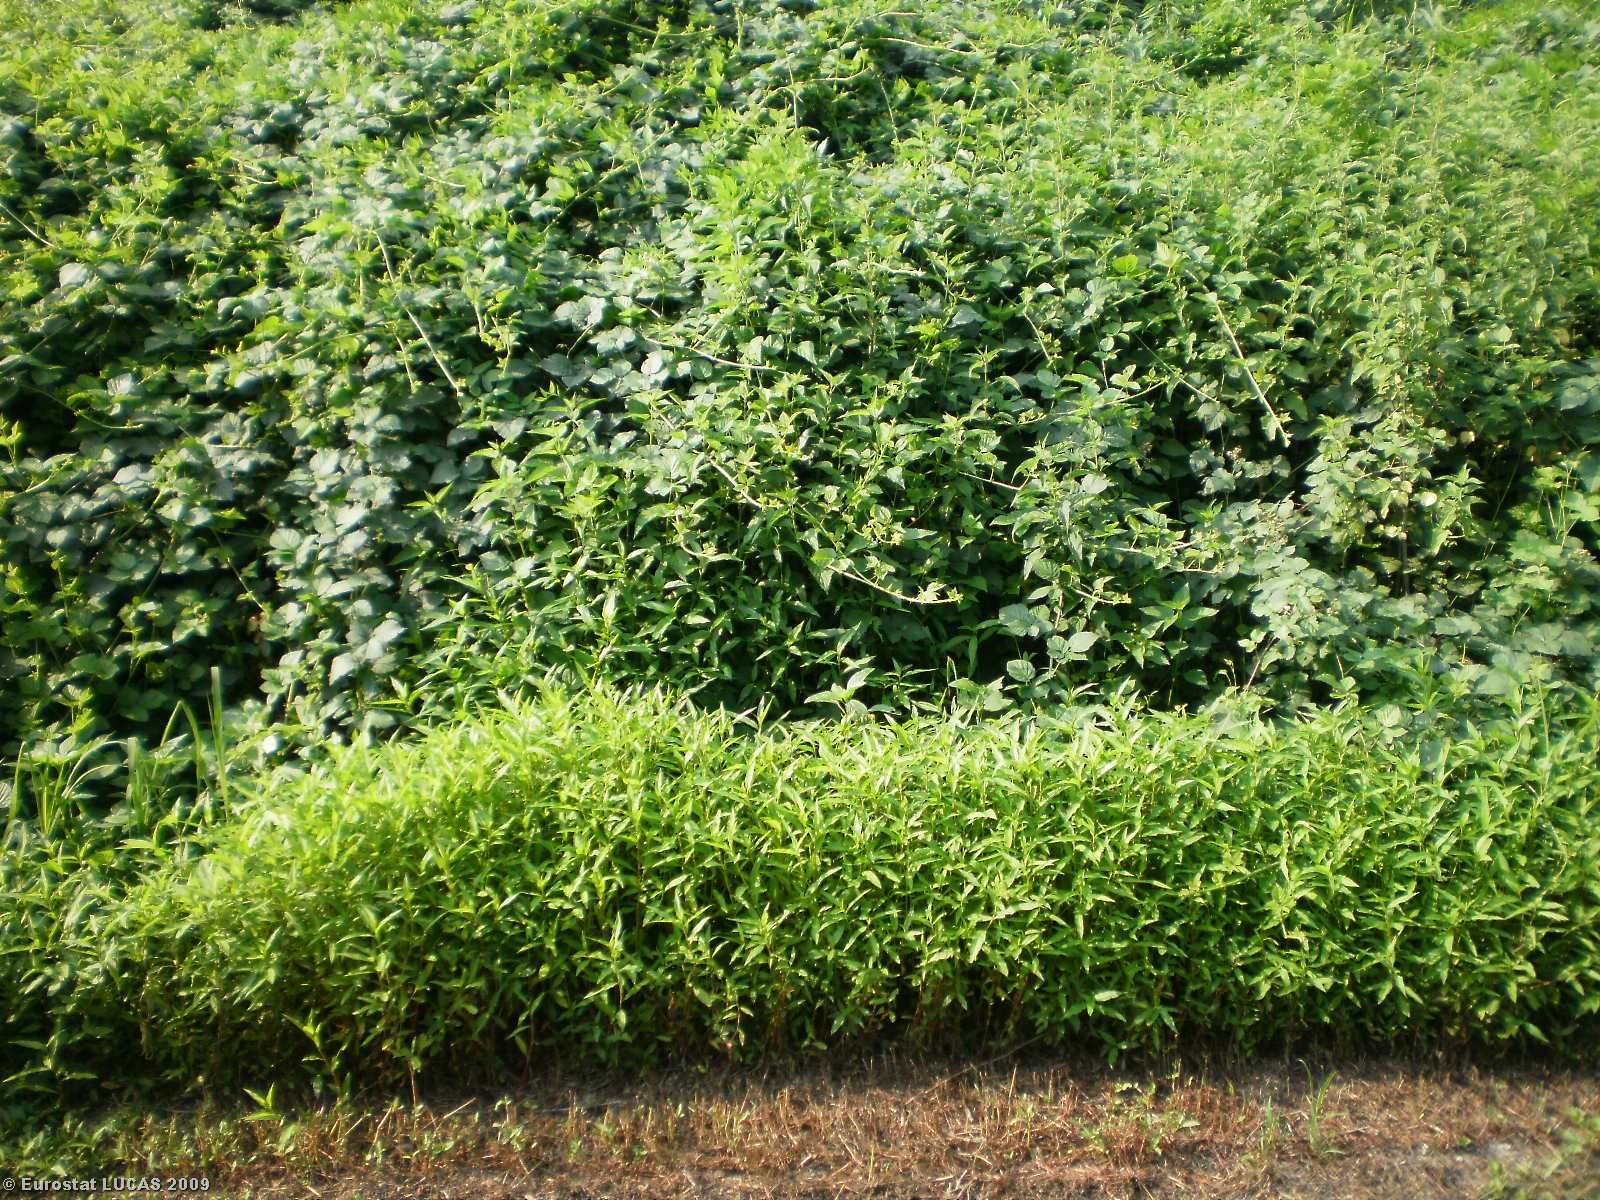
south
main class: Woodland
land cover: Broadleaved woodland
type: non-riverine alder, birch or aspen forest
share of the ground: > 75 %
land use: Forestry
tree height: > 5 m
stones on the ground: < 10 %
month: July
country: IT
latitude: 44.9447
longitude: 10.4427
